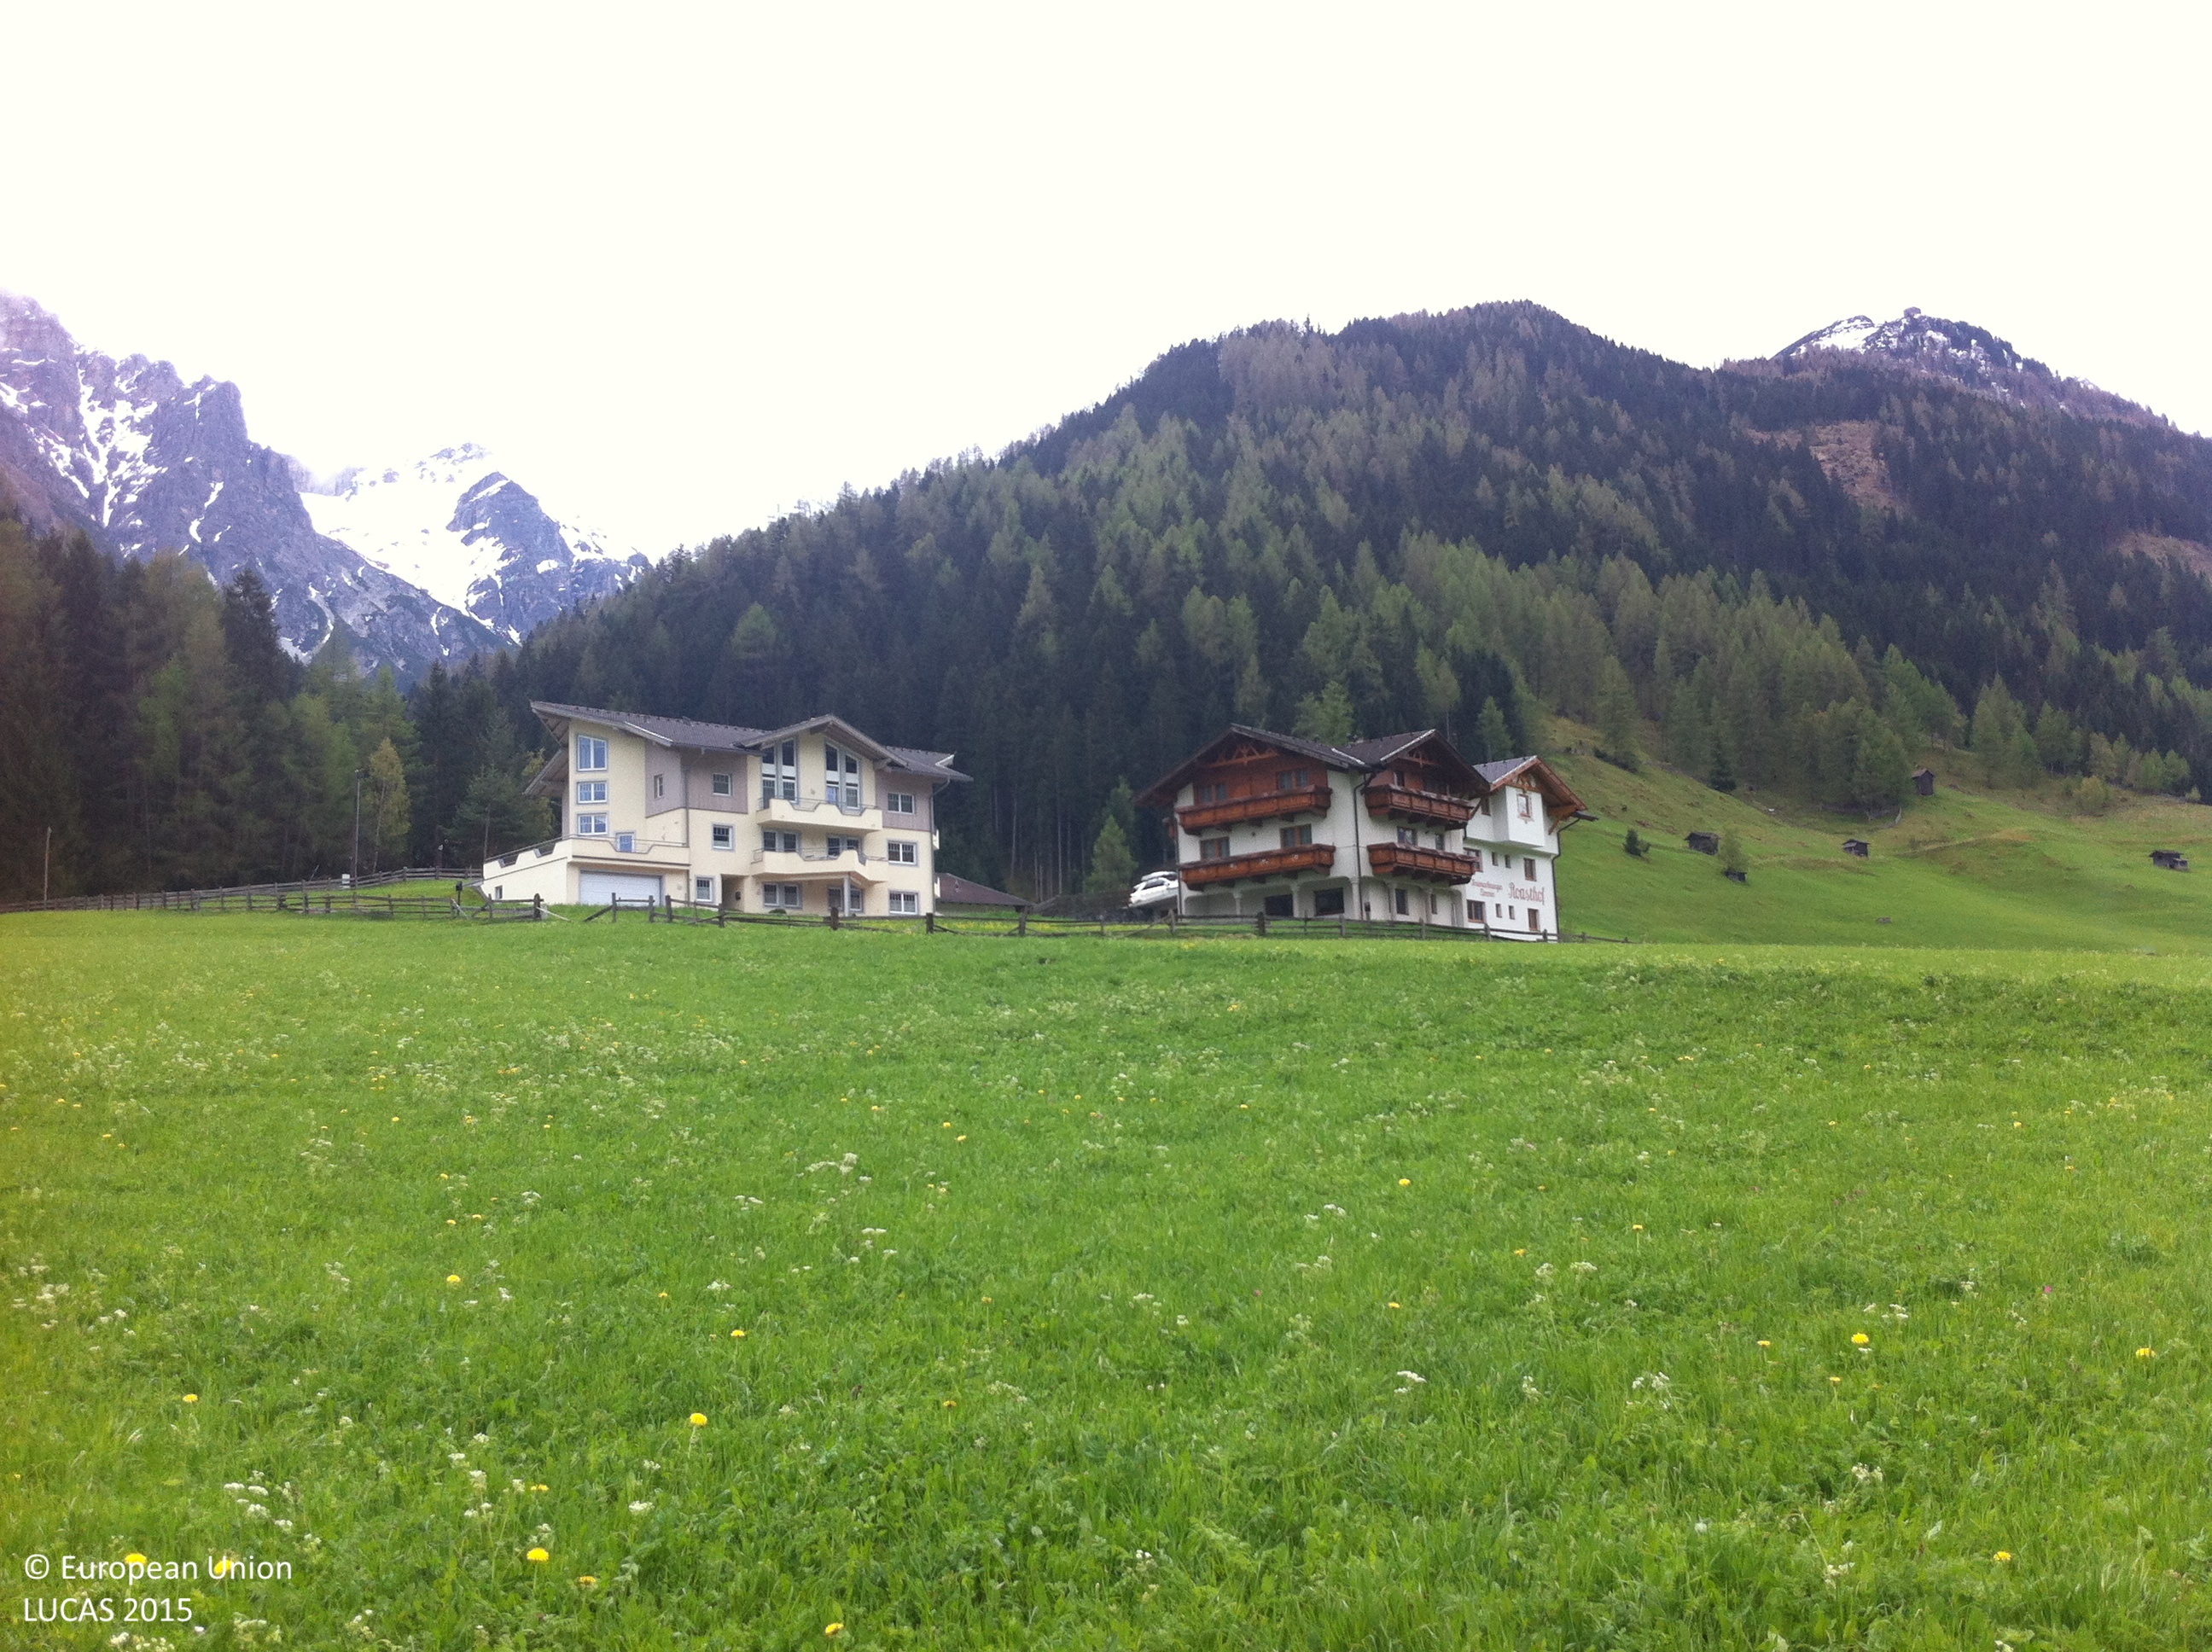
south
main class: Grassland
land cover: Grassland without tree/shrub cover
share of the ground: > 75 %
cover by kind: herbaceous plants 100 %
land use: Agriculture (excluding fallow land and kitchen gardens)
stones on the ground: < 10 %
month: May
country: AT
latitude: 47.1174
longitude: 11.3299
